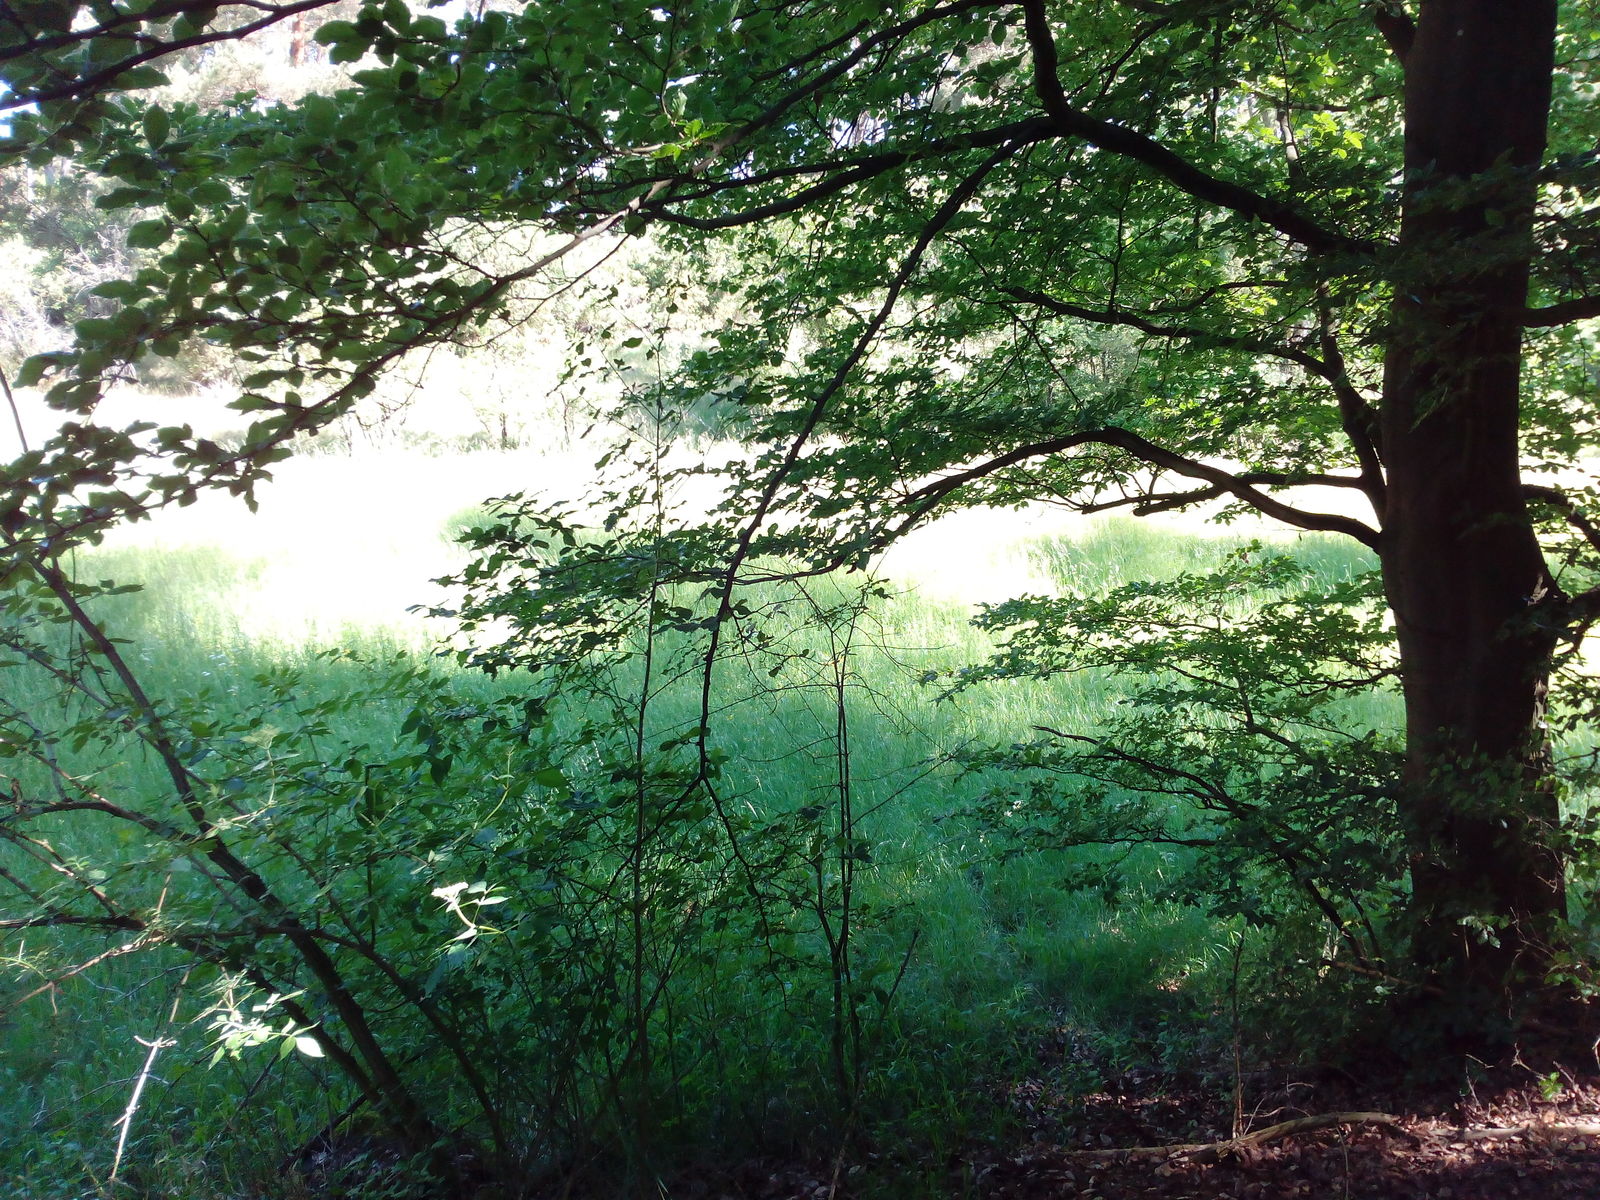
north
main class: Woodland
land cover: Other mixed woodland
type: hemiboreal forest and nemoral coniferous forest and mixed broadleaved-coniferous forest
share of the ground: 50 - 75 %
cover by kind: coniferous forest trees 40 %, broadleaved forest trees 25 %, herbaceous plants 20 %, shrubs 15 %
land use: Forestry
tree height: > 5 m
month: June
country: DE
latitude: 50.3997
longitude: 10.2672
